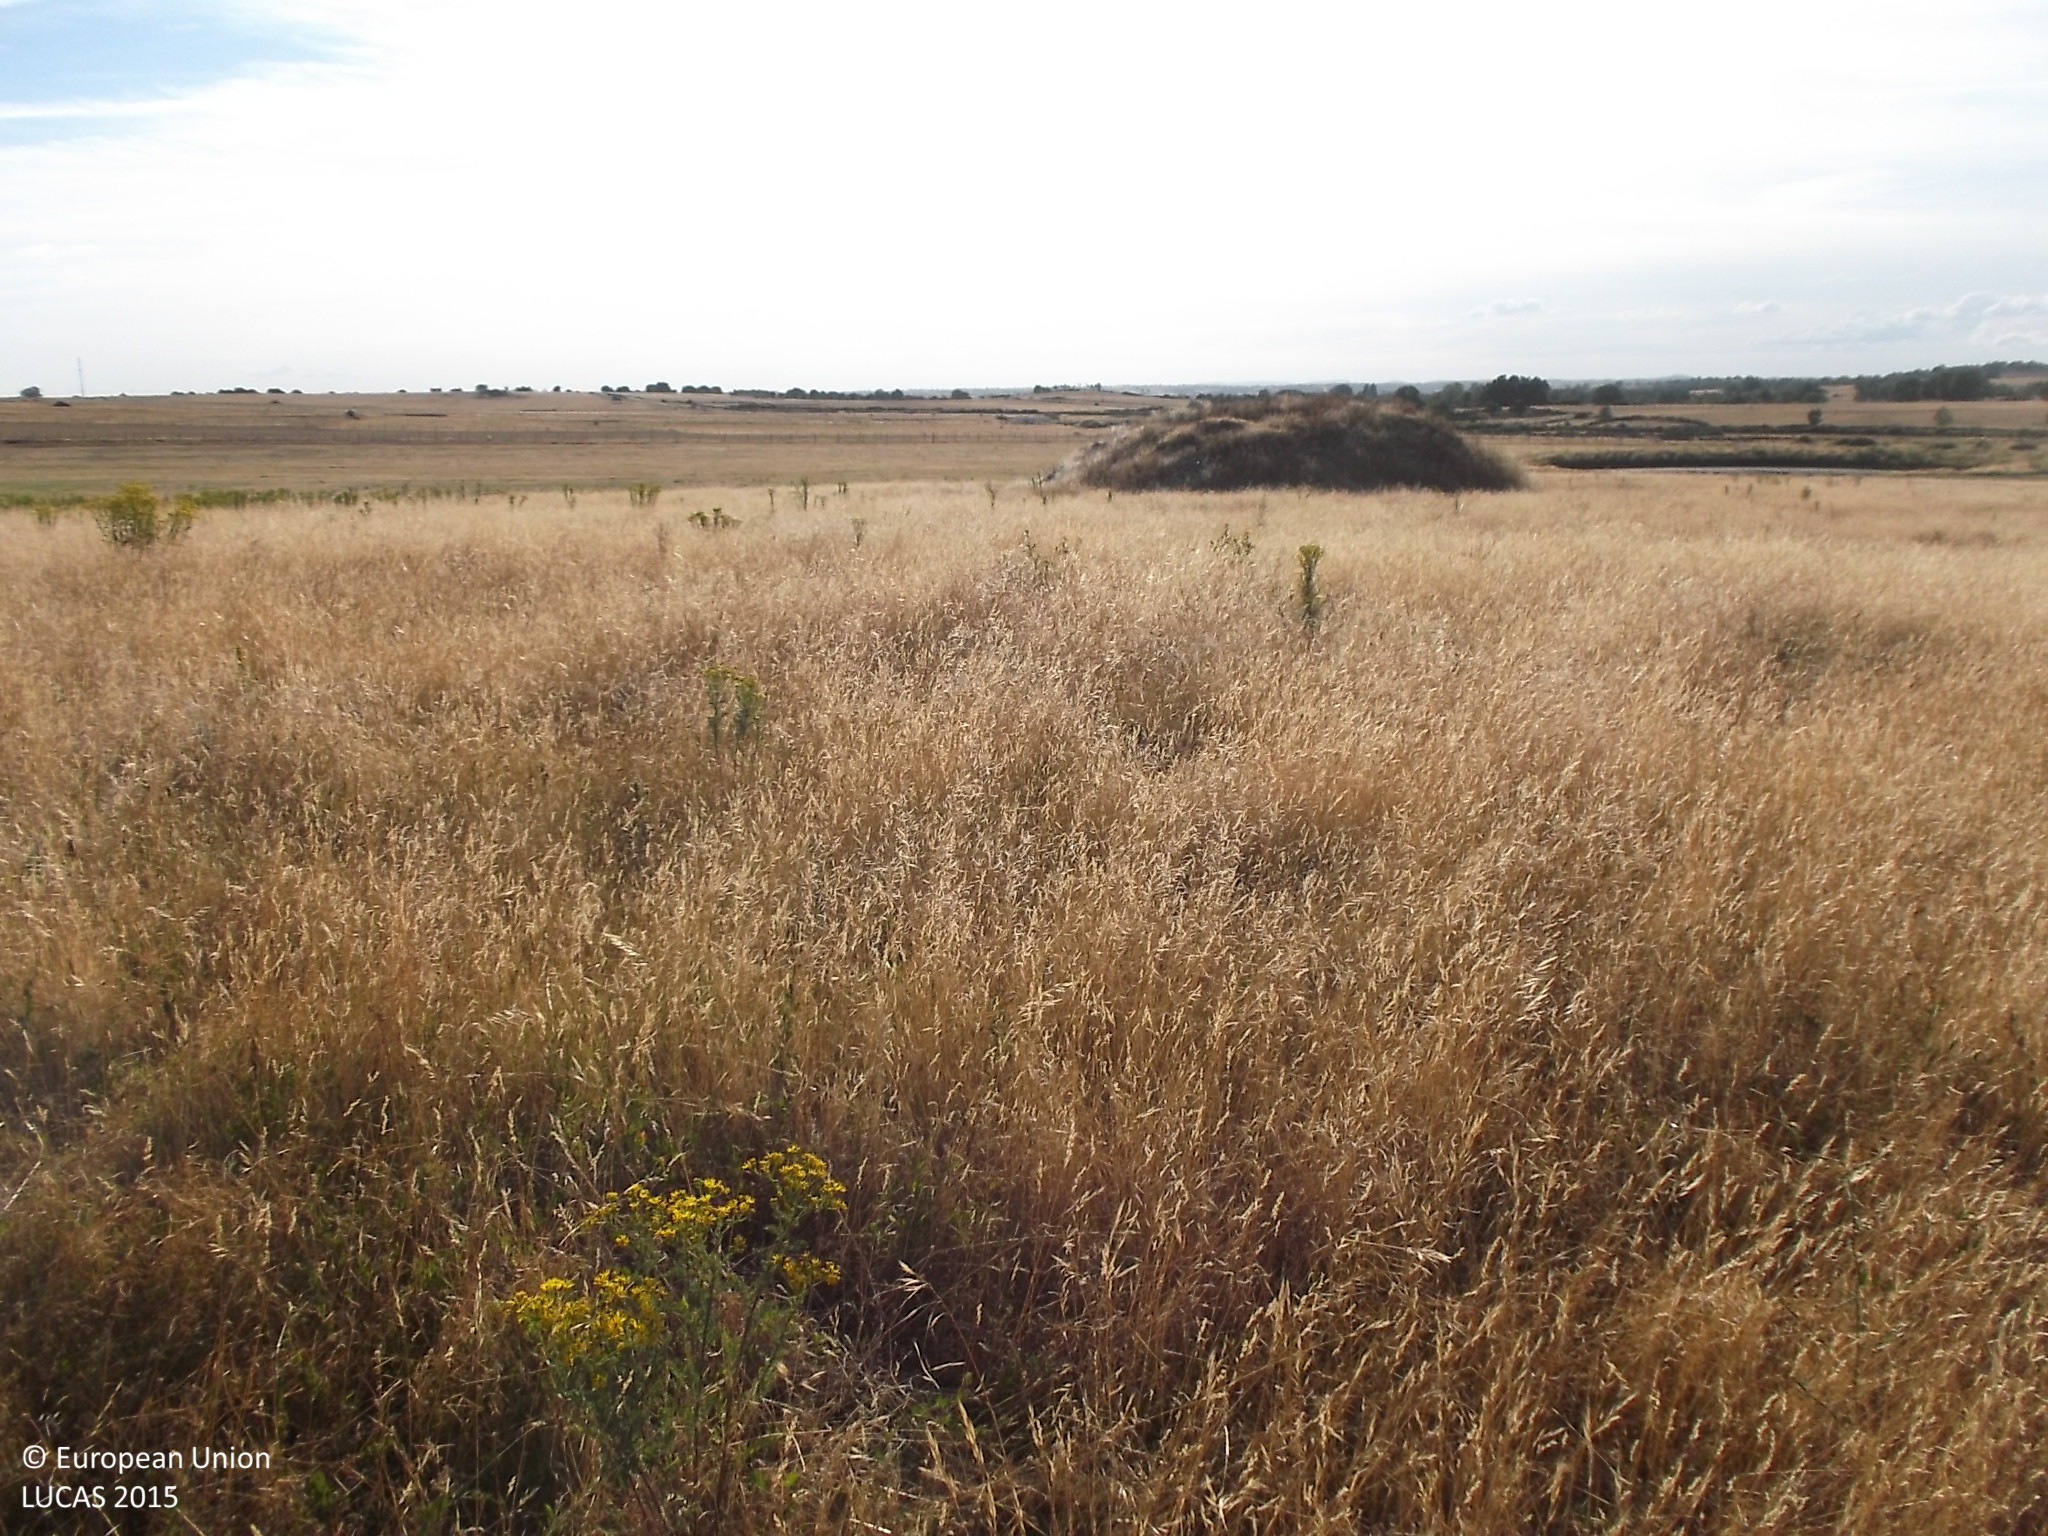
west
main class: Grassland
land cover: Grassland without tree/shrub cover
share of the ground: > 75 %
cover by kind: herbaceous plants 100 %
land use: Agriculture (excluding fallow land and kitchen gardens)
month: July
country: ES
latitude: 41.0189
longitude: -6.4700
